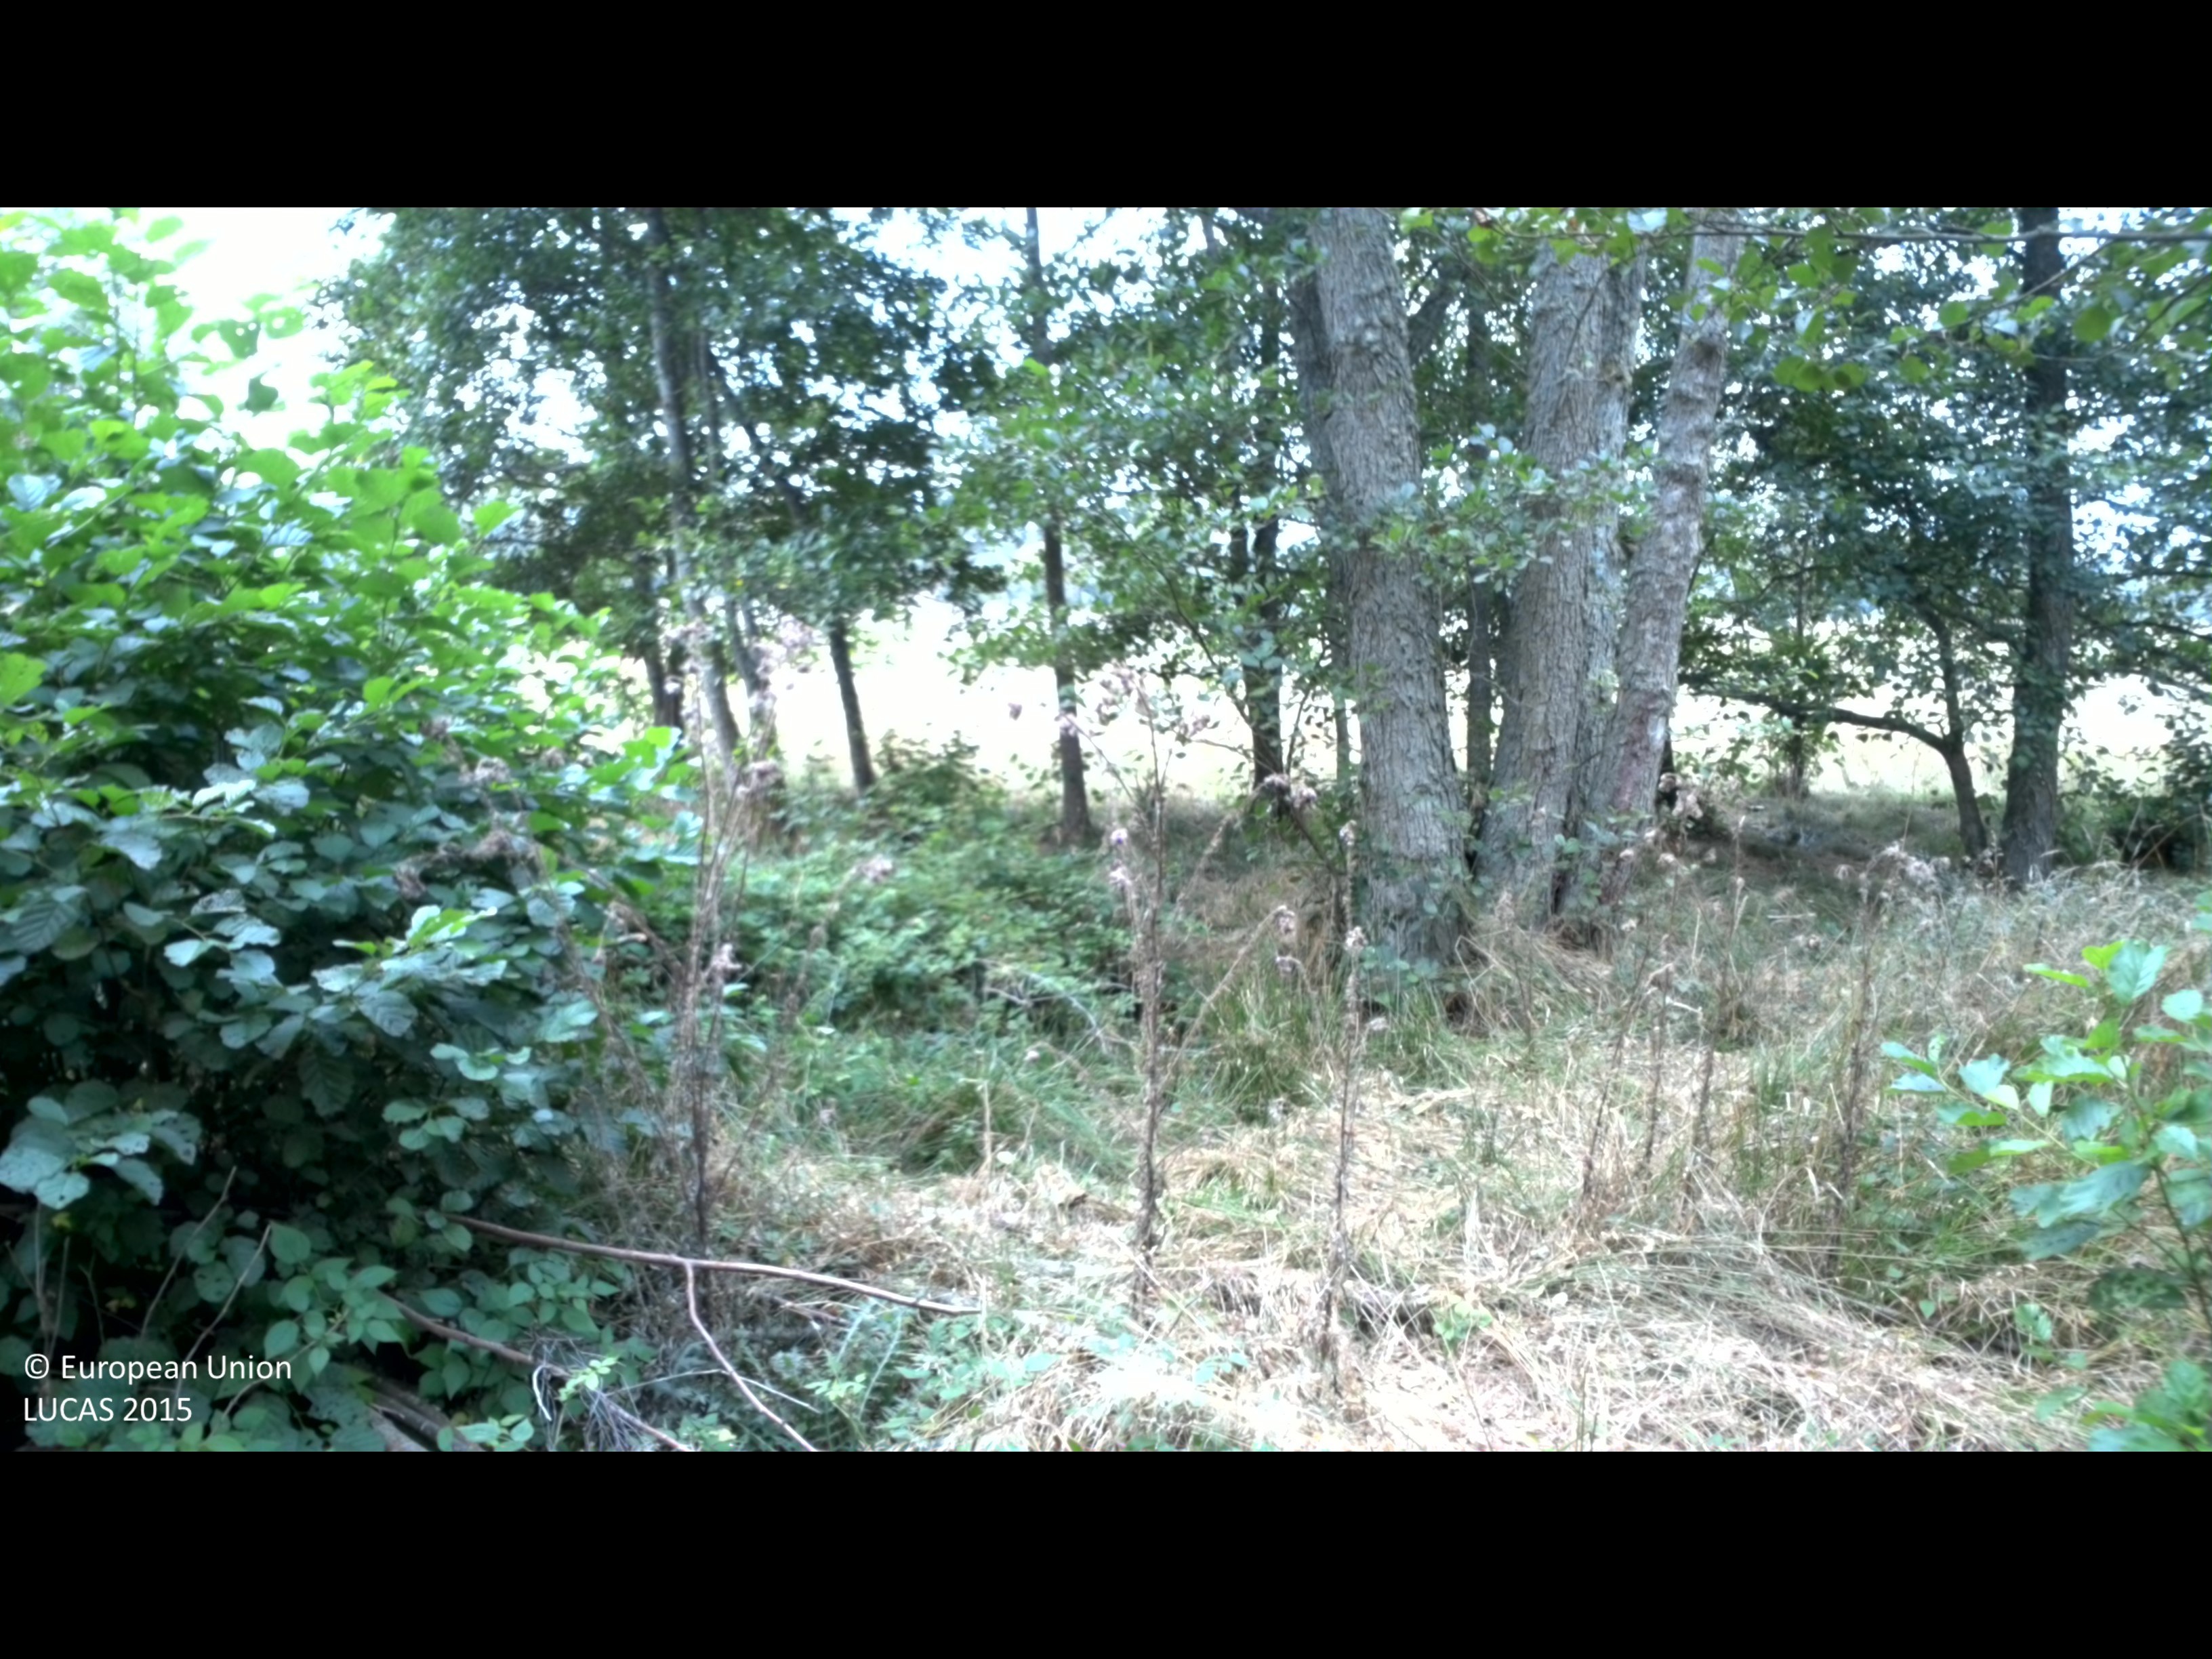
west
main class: Woodland
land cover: Broadleaved woodland
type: hemiboreal forest and nemoral coniferous forest and mixed broadleaved-coniferous forest
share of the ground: 10 - 25 %
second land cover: Grassland without tree/shrub cover
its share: > 75 %
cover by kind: herbaceous plants 60 %, broadleaved forest trees 25 %, shrubs 15 %
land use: Forestry
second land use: Agriculture (excluding fallow land and kitchen gardens)
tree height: > 5 m
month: August
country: SE
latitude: 56.1811
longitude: 15.4286
